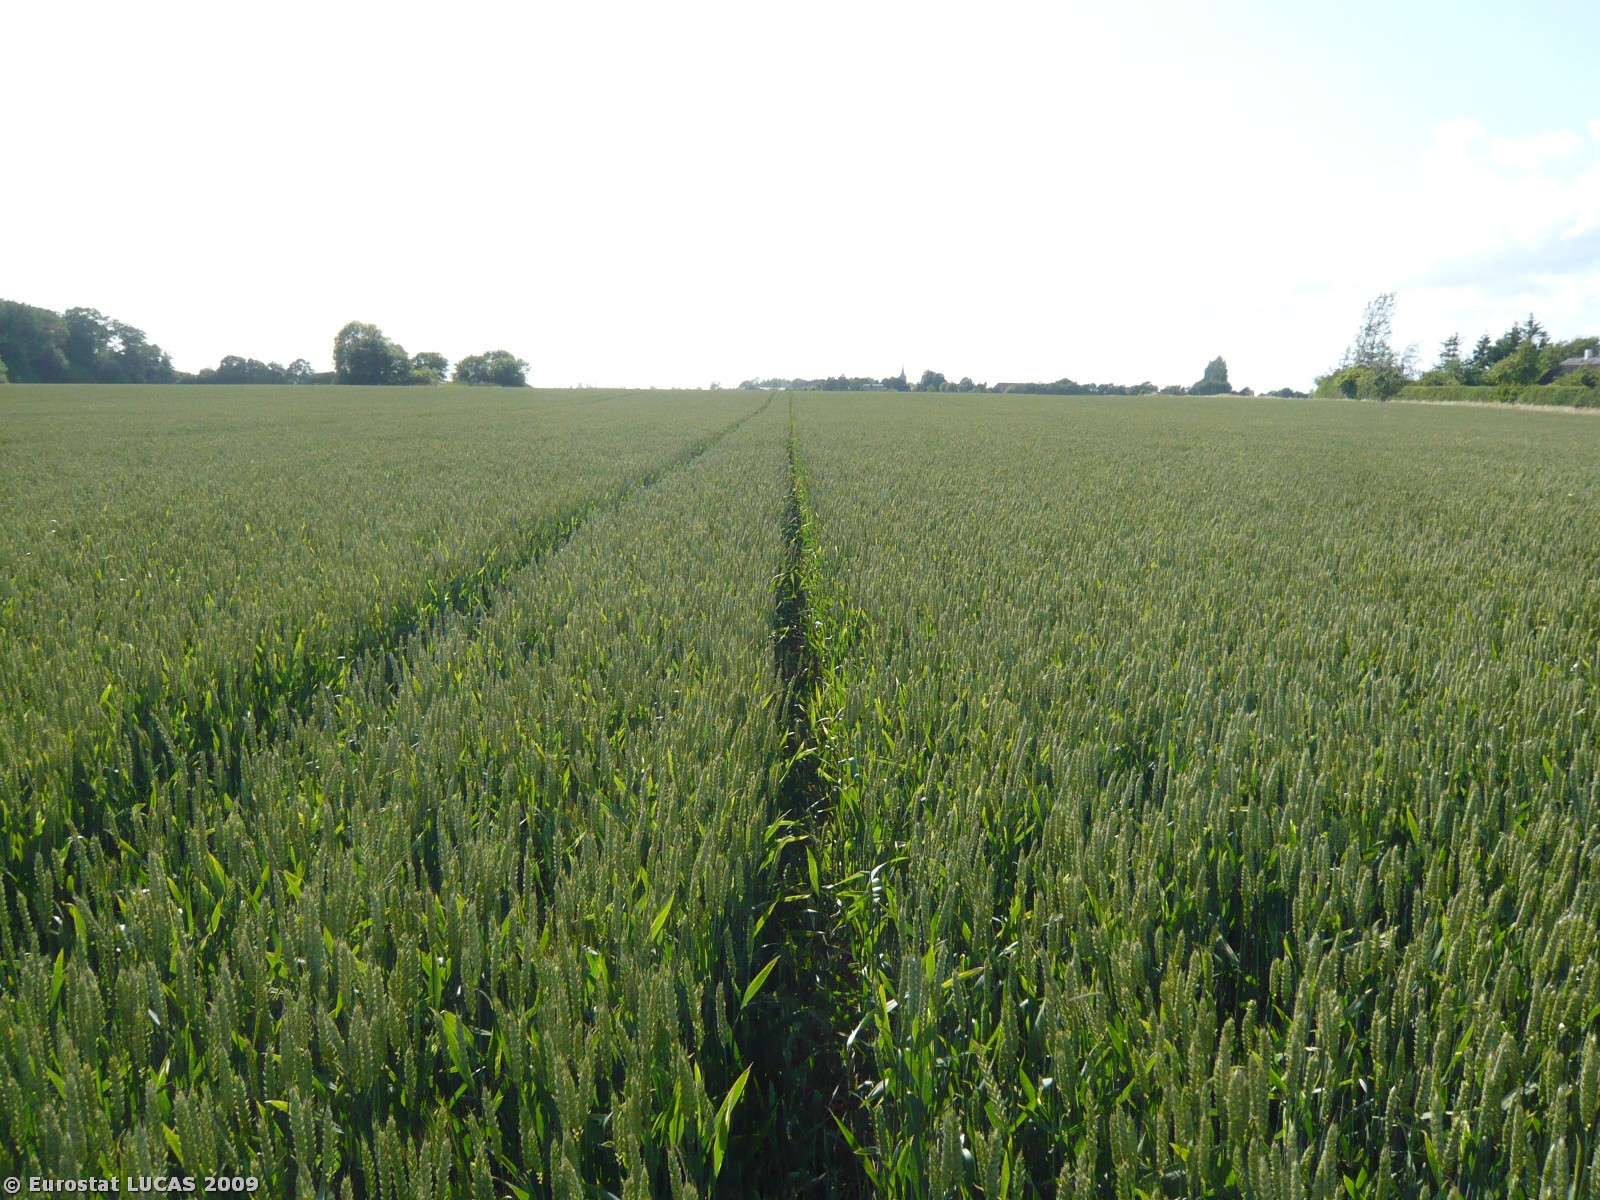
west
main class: Cropland
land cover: Common wheat
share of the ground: > 75 %
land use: Agriculture (excluding fallow land and kitchen gardens)
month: June
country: DK
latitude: 54.7044
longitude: 11.5354
